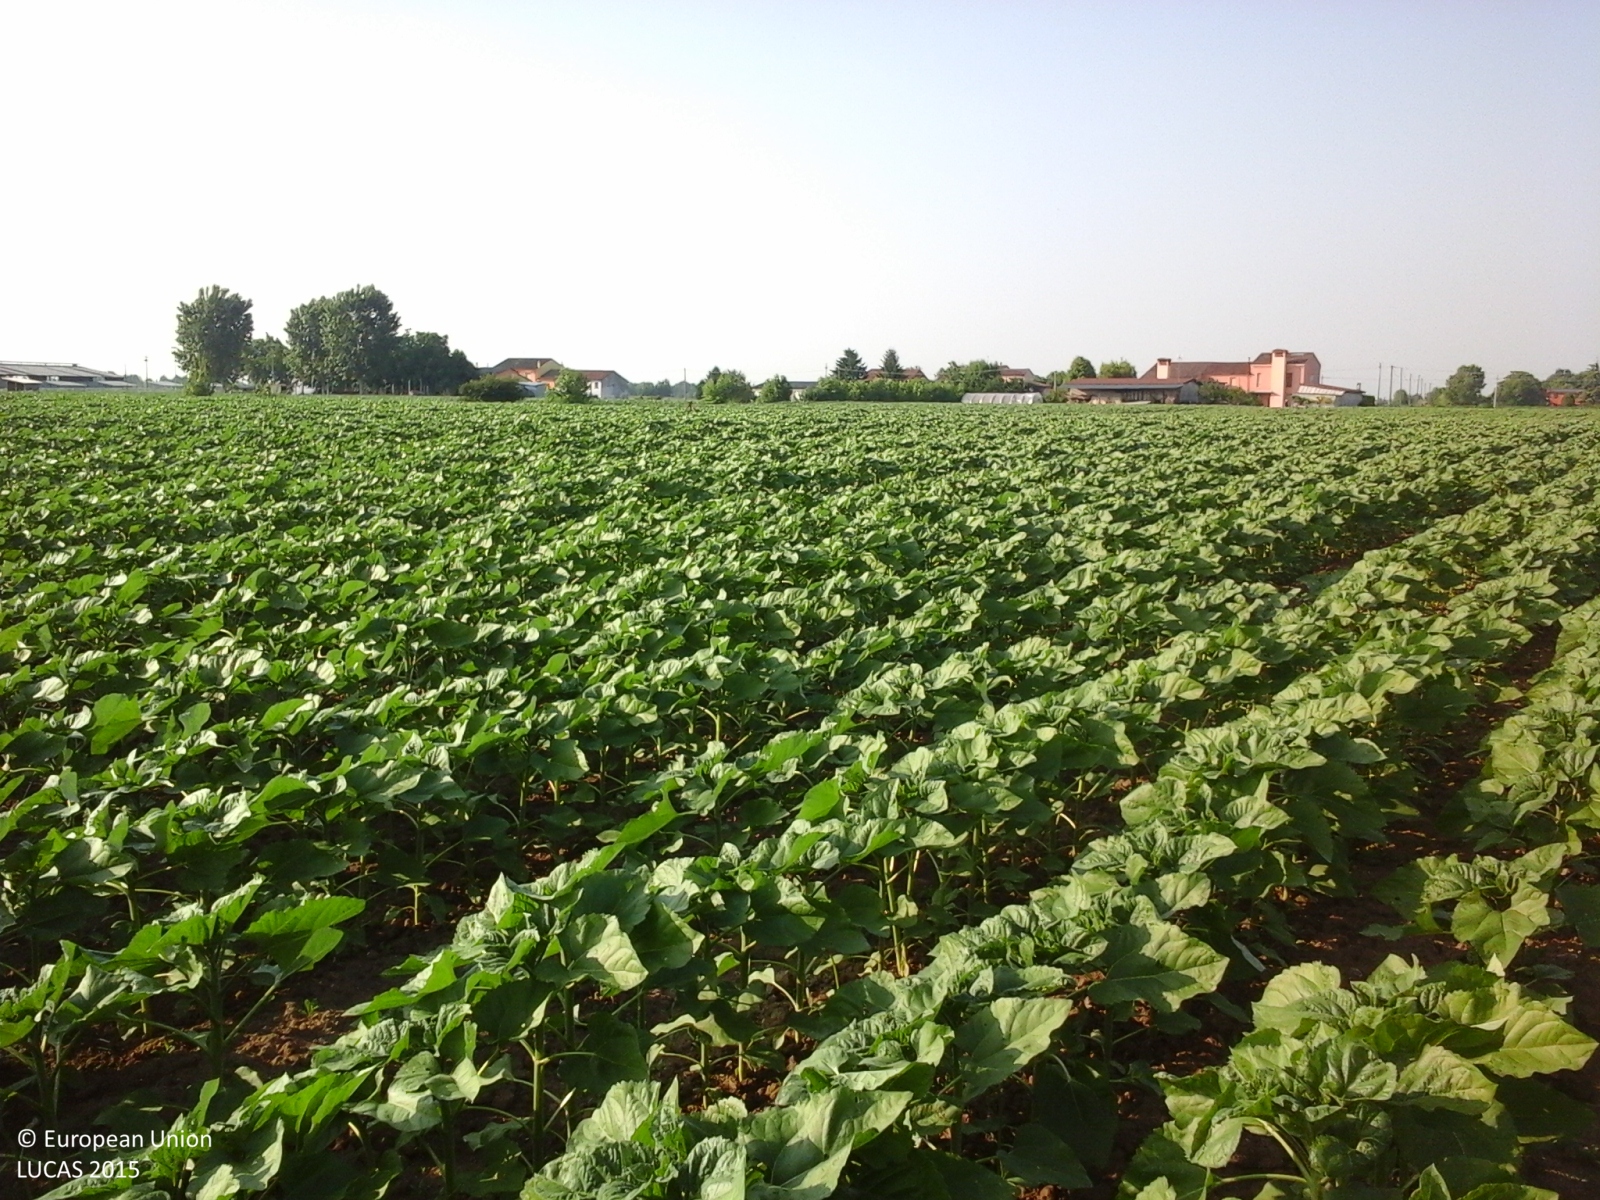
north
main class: Cropland
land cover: Sunflower
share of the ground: > 75 %
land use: Agriculture (excluding fallow land and kitchen gardens)
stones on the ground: < 10 %
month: May
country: IT
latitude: 45.2302
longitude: 10.9027
